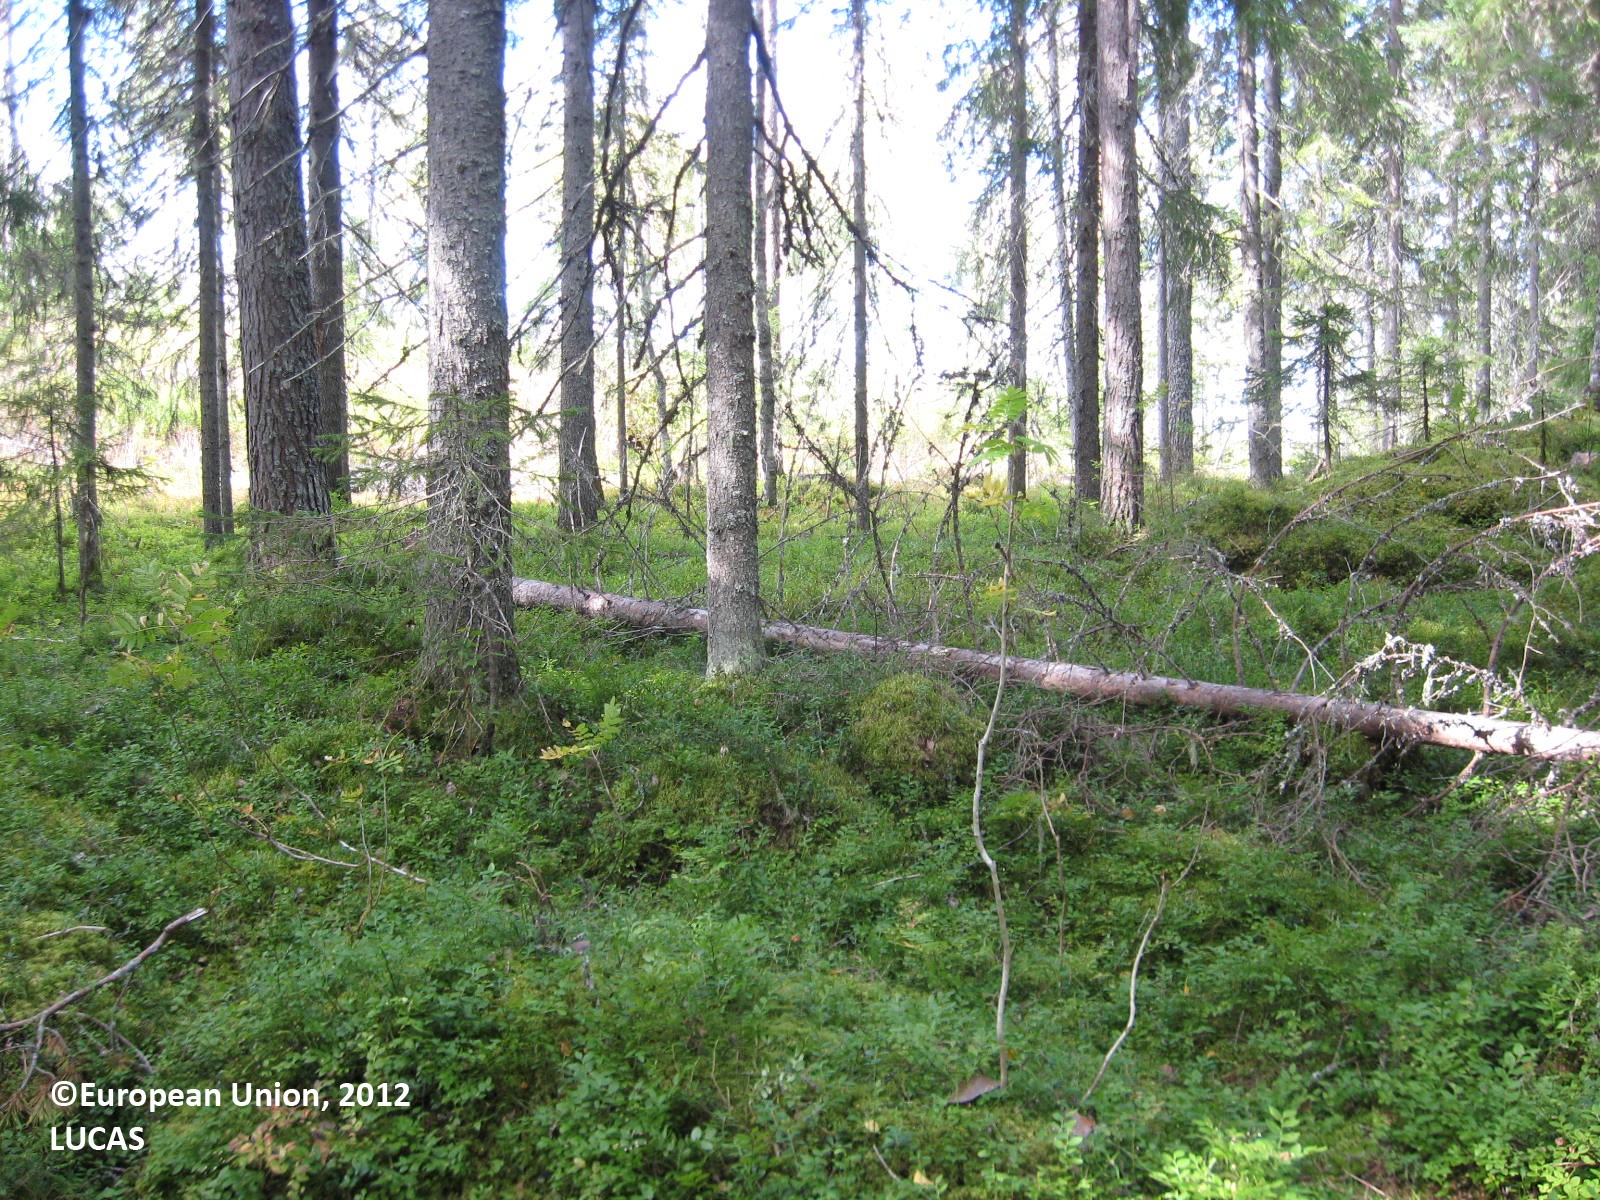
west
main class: Woodland
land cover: Spruce dominated coniferous woodland
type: boreal forest
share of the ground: > 75 %
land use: Forestry
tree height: > 5 m
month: August
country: FI
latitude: 63.8001
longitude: 29.8270
